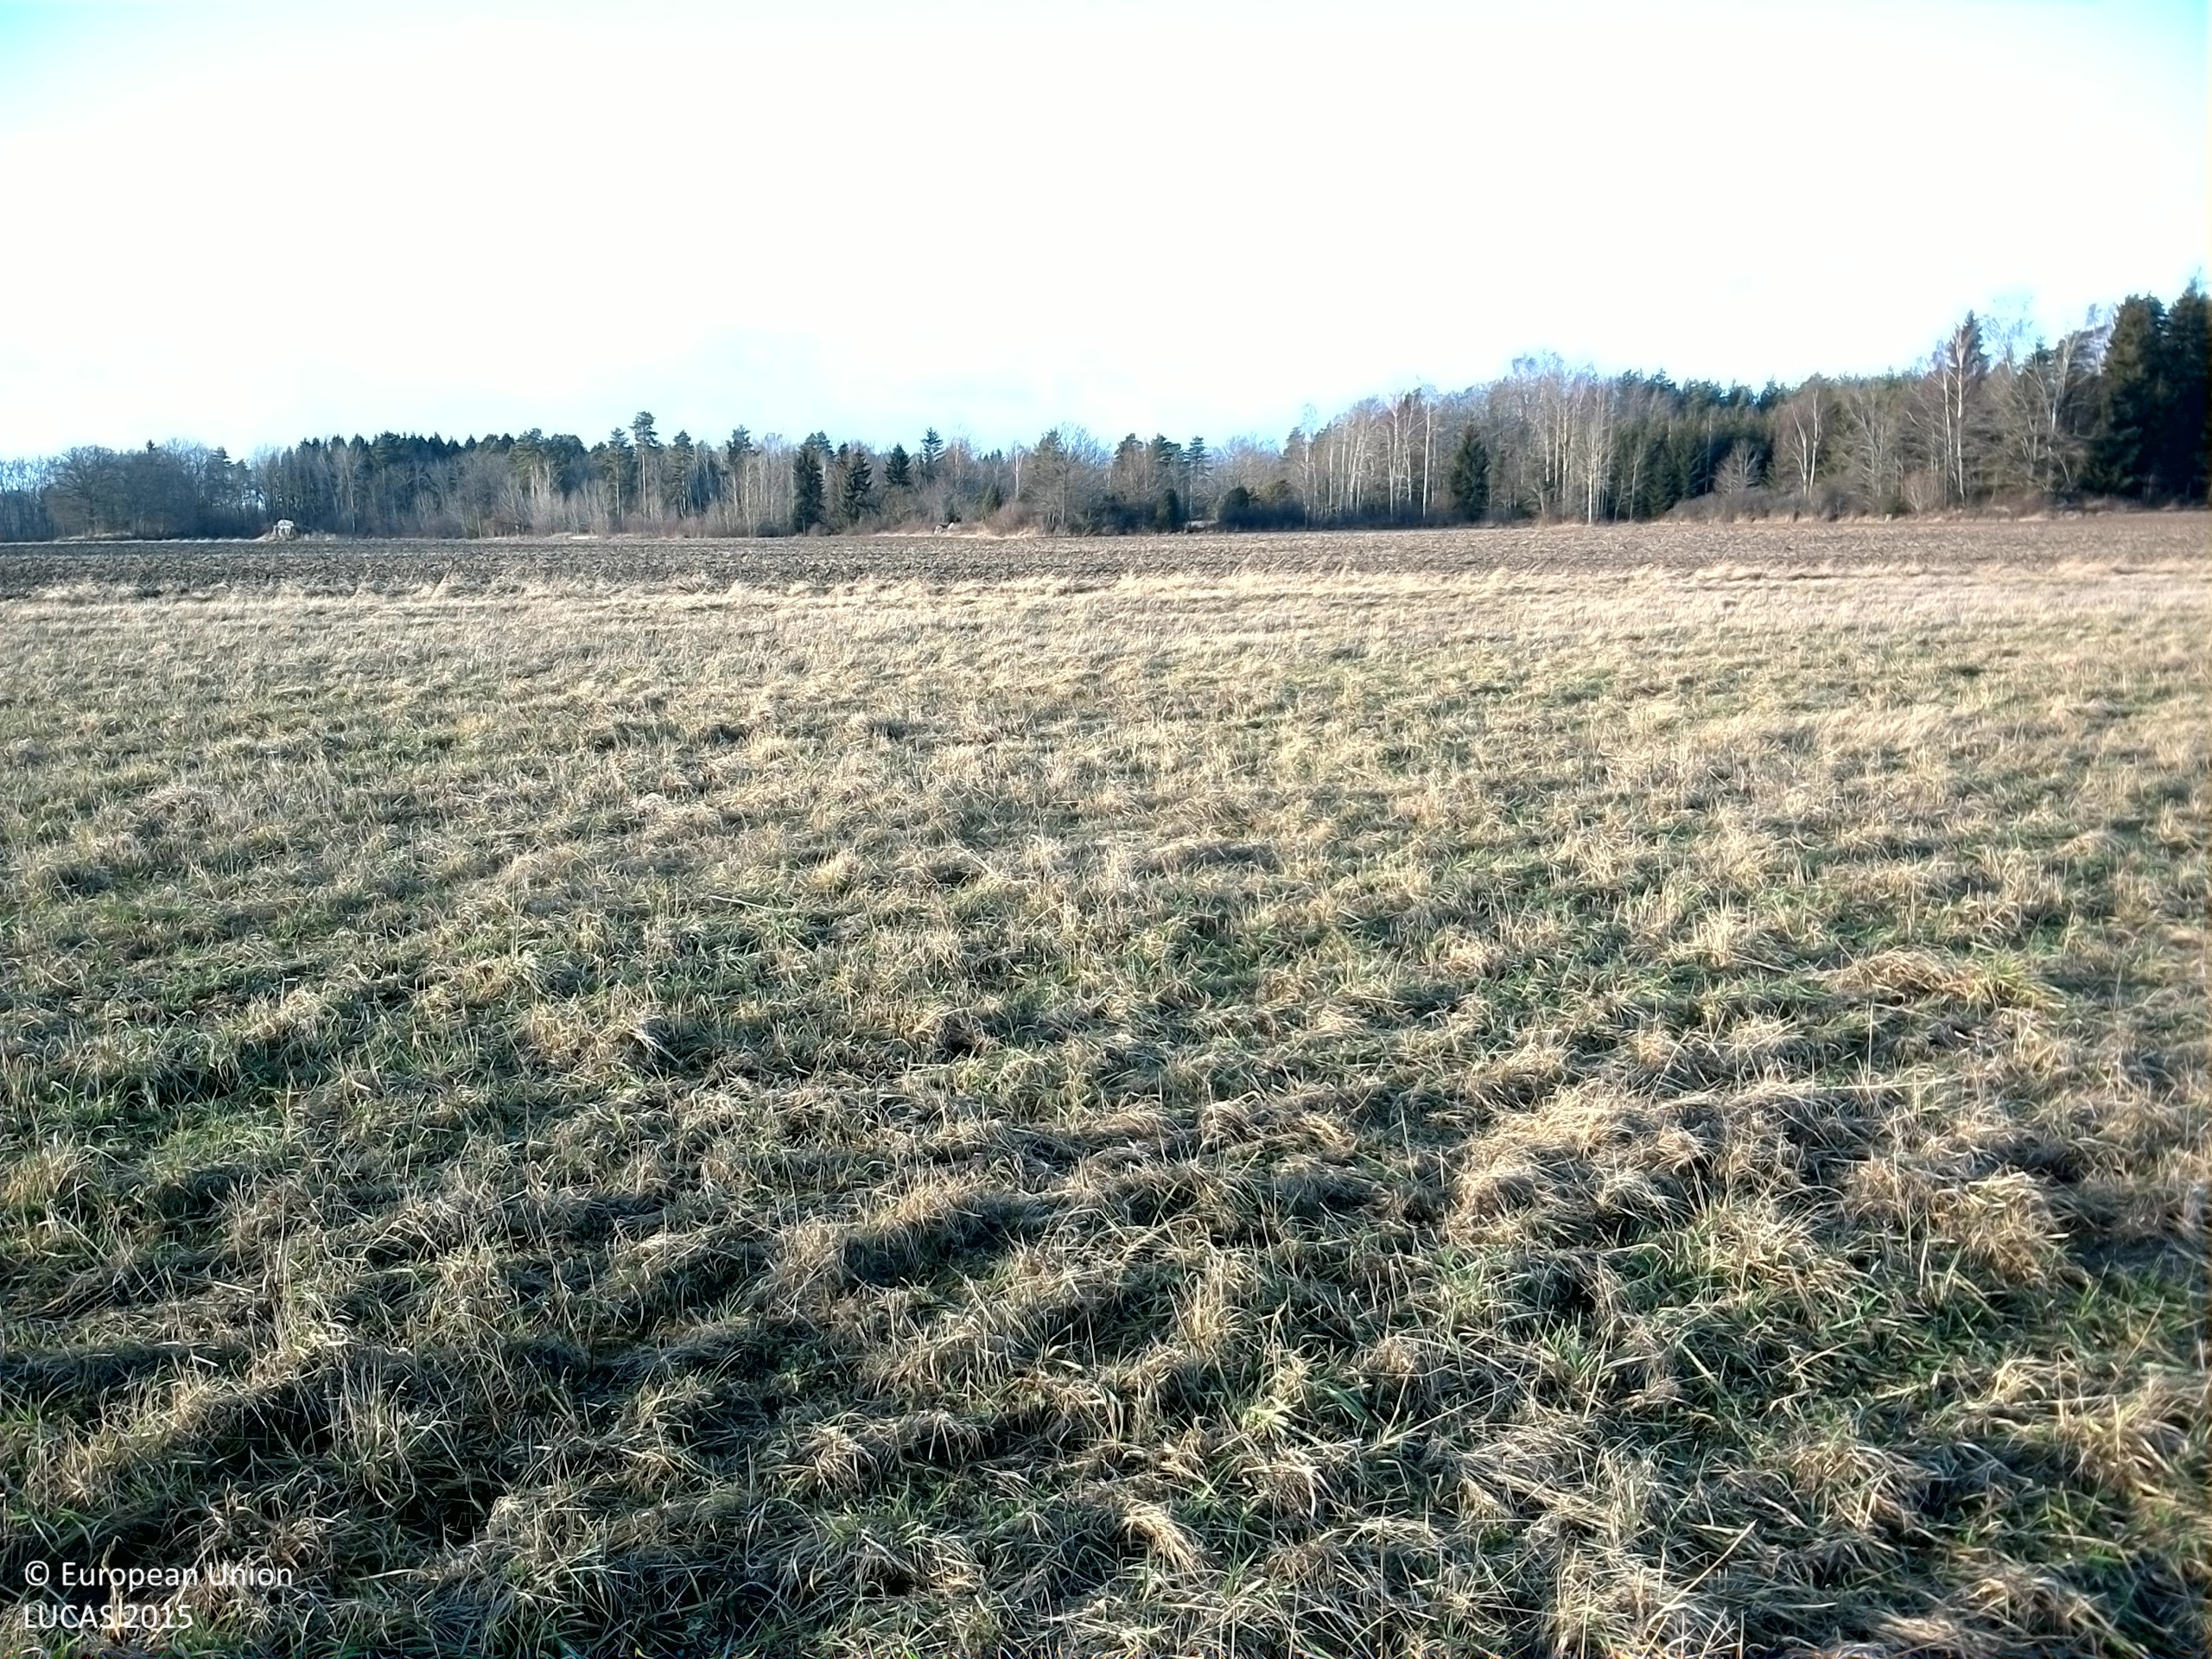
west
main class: Grassland
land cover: Grassland without tree/shrub cover
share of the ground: > 75 %
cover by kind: herbaceous plants 100 %
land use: Agriculture (excluding fallow land and kitchen gardens)
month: December
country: SE
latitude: 59.3786
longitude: 16.9112
